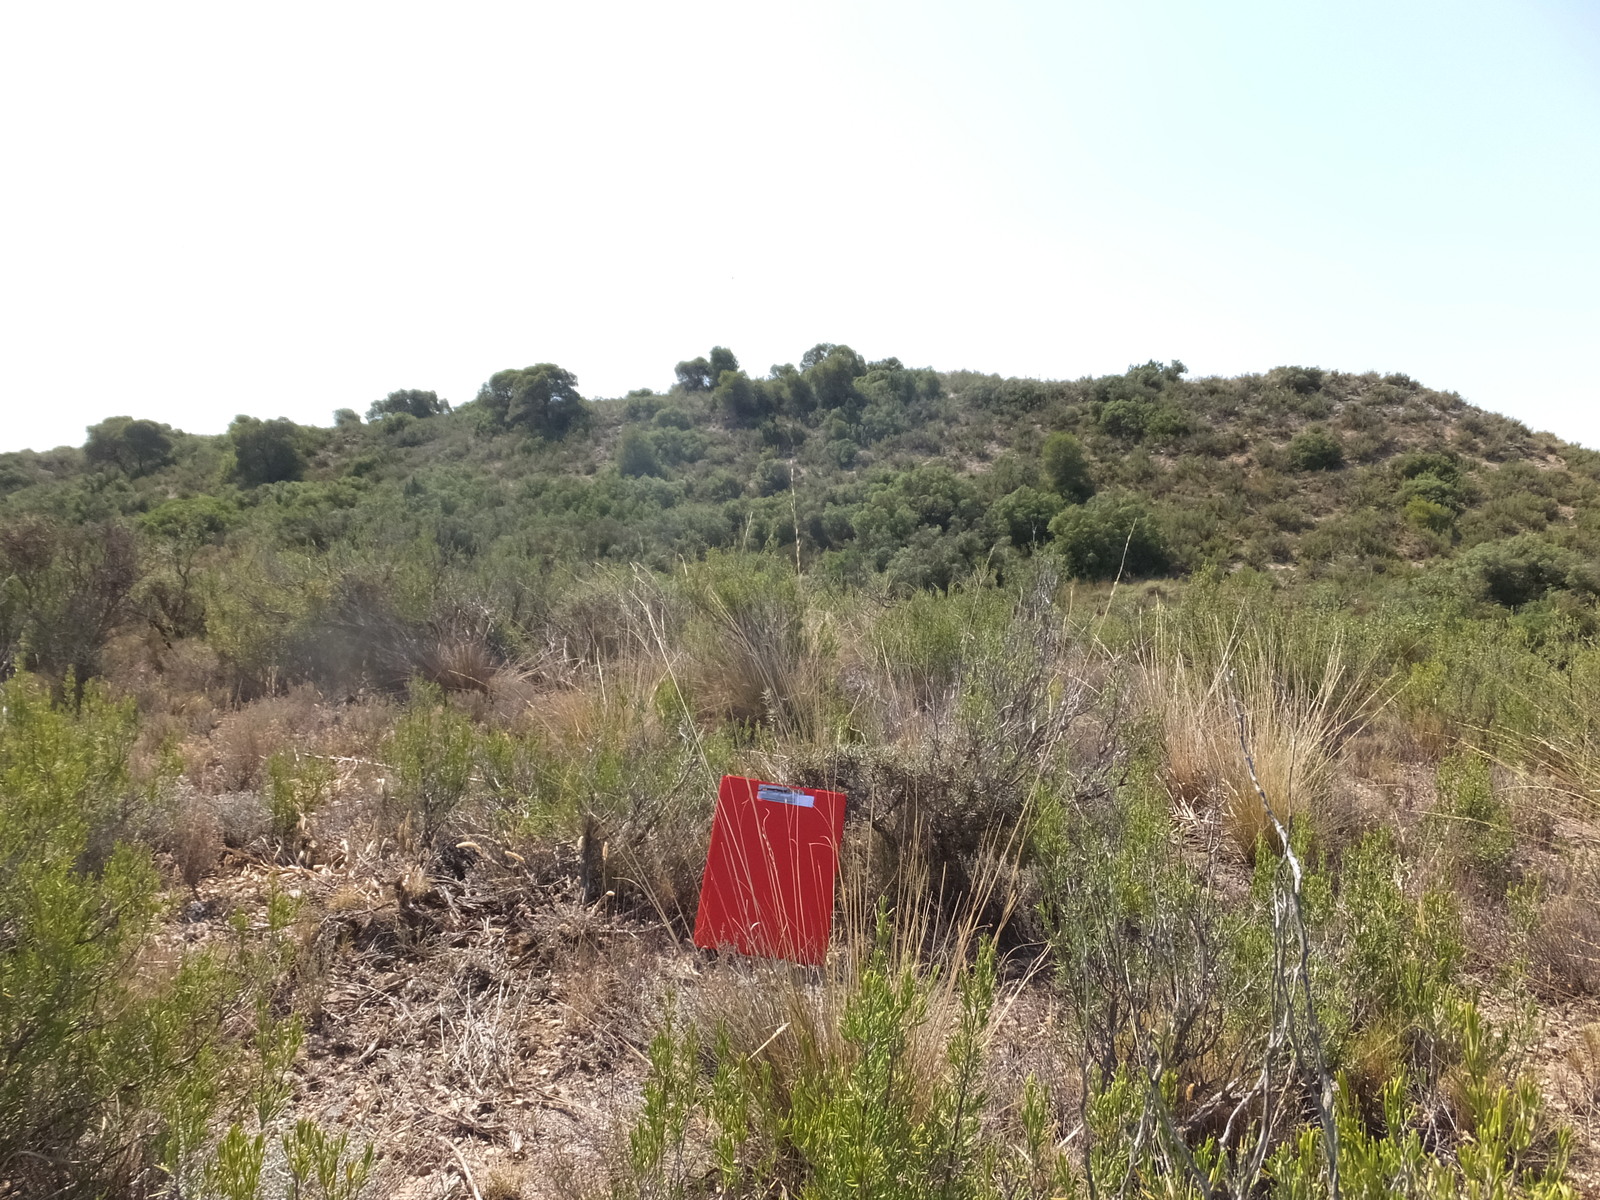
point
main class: Shrubland
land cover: Shrubland with sparse tree cover
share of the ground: > 75 %
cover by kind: shrubs 70 %, herbaceous plants 25 %, coniferous forest trees 5 %
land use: Semi-natural and natural areas not in use
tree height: < 5 m
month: June
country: ES
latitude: 41.3843
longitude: -0.0949
